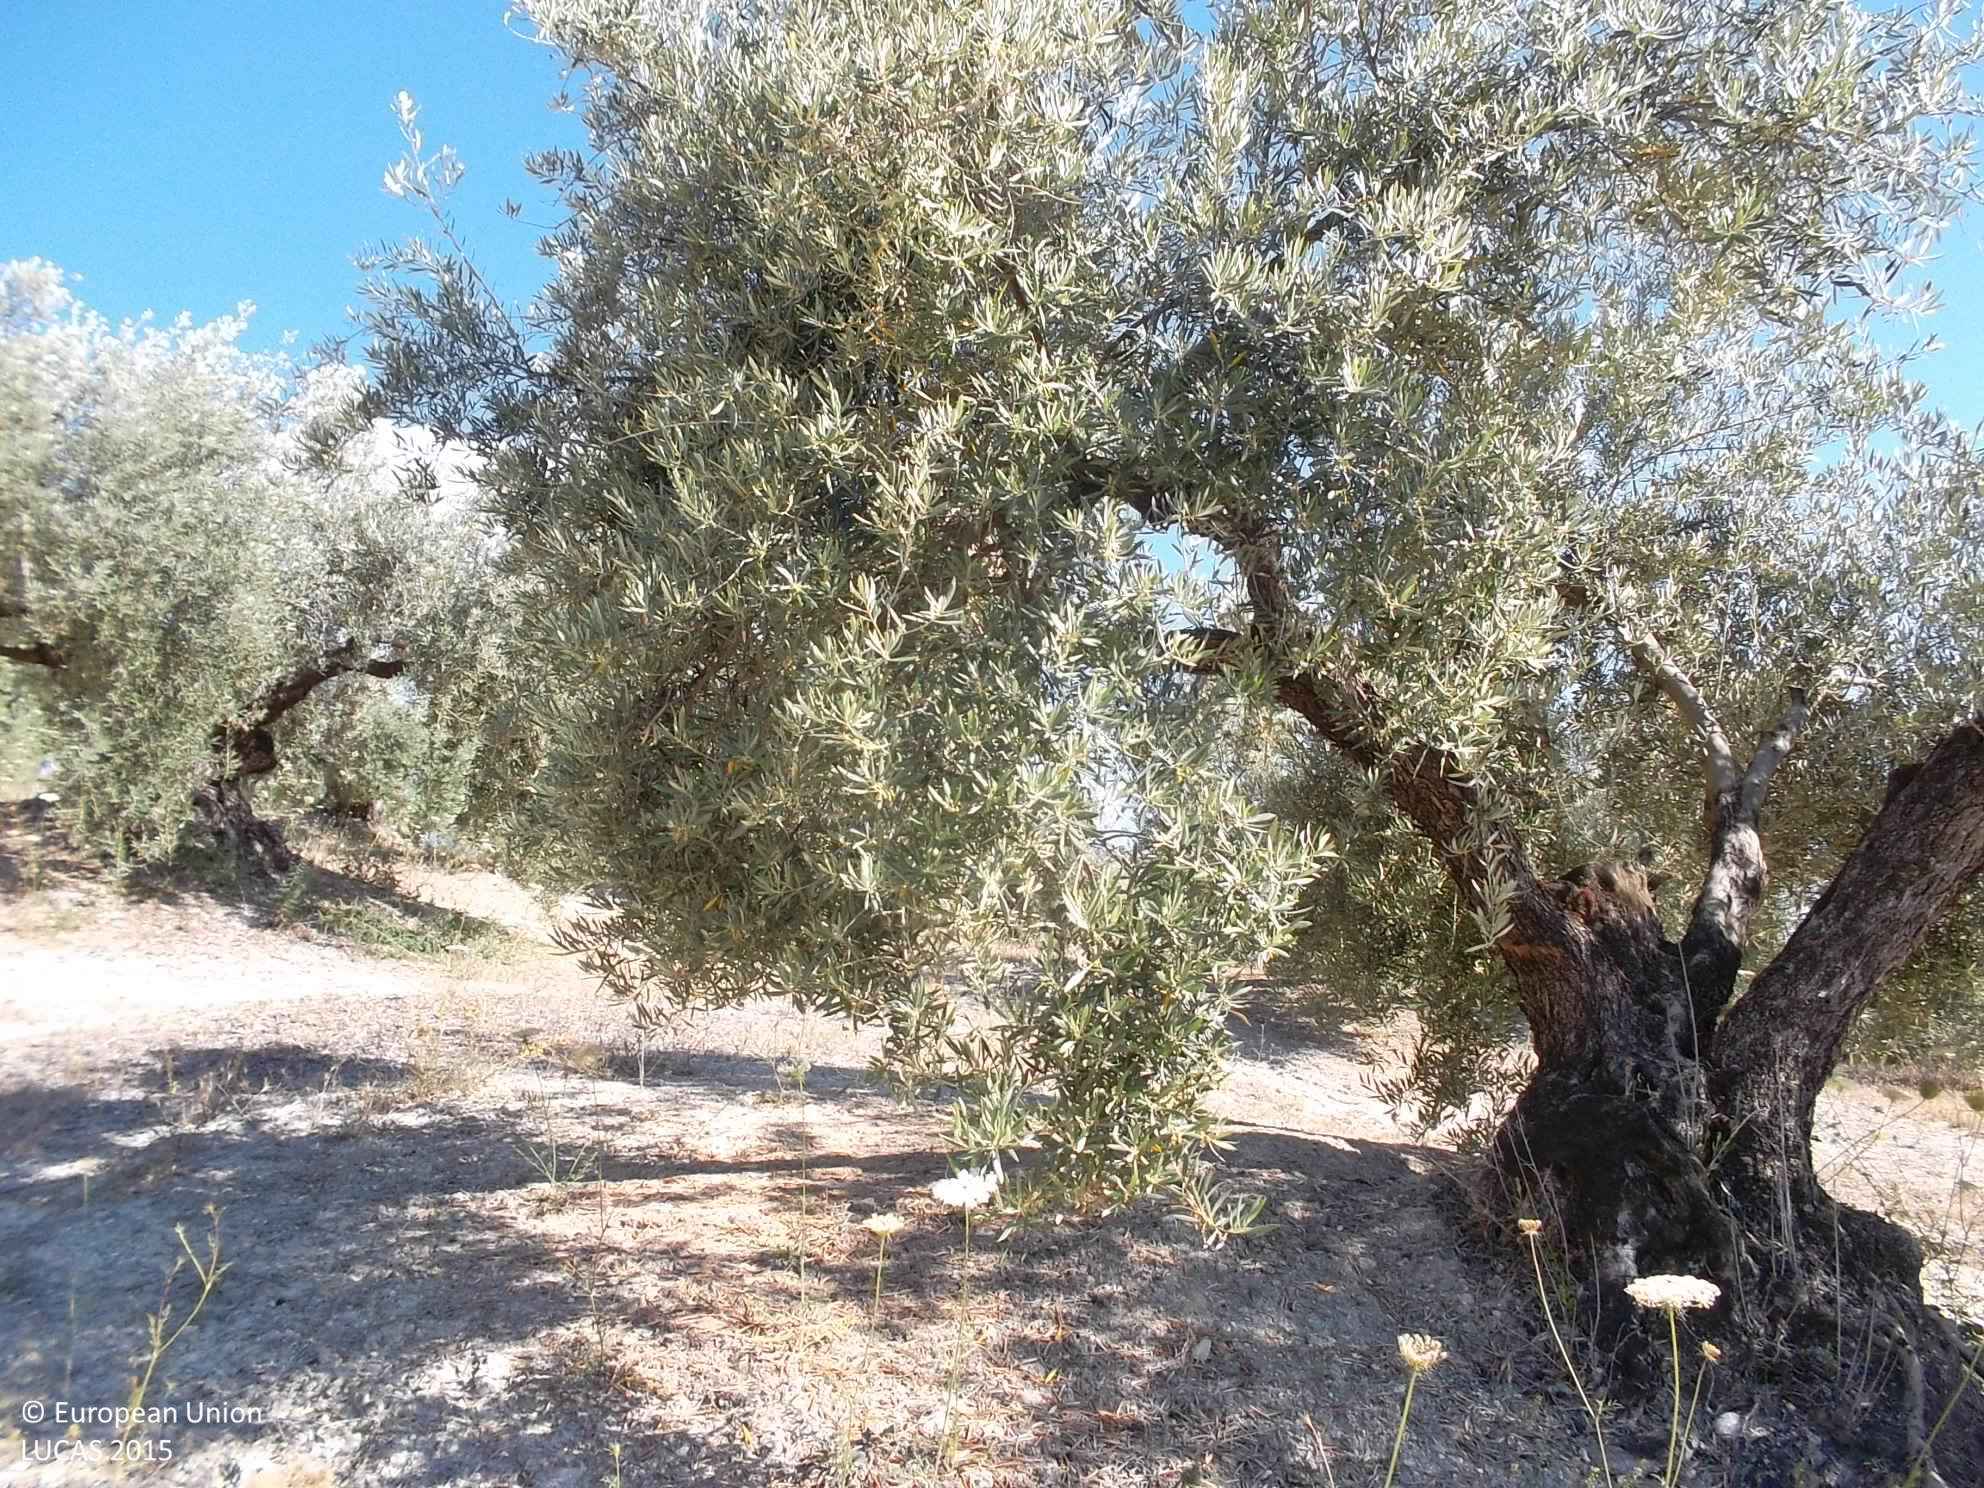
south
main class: Cropland
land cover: Olive groves
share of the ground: 50 - 75 %
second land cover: Other bare soil
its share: > 75 %
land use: Agriculture (excluding fallow land and kitchen gardens)
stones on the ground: < 10 %
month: June
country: ES
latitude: 38.0192
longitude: -3.0396
